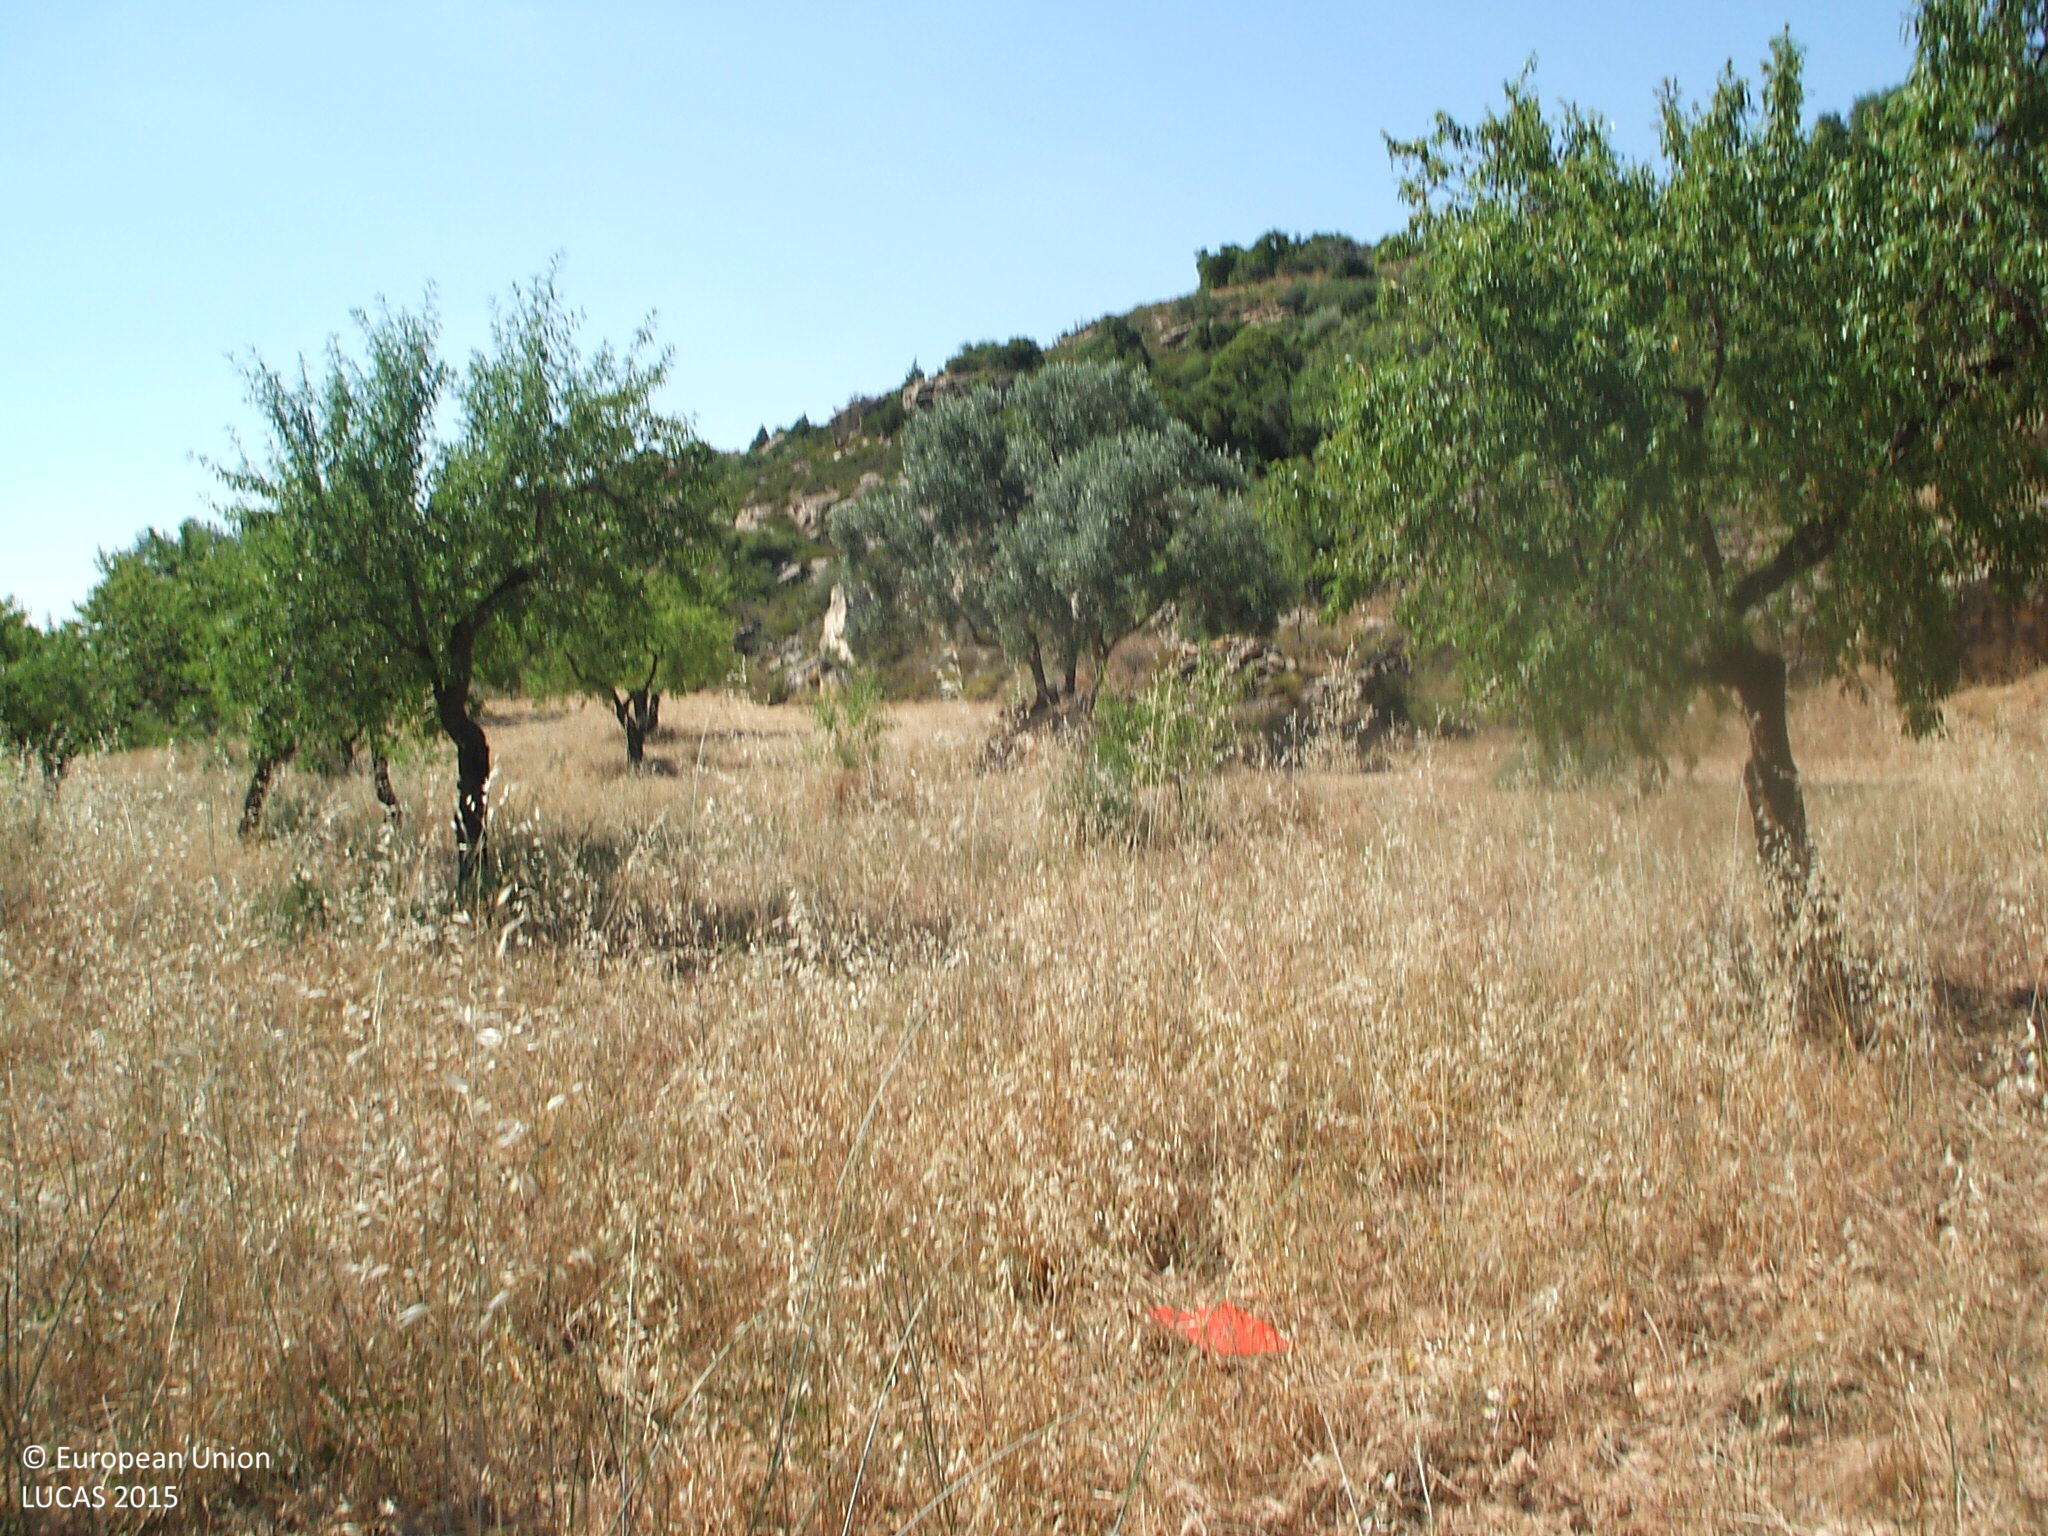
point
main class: Cropland
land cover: Nuts trees
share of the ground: 25 - 50 %
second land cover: Spontaneously vegetated surfaces
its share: > 75 %
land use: Agriculture (excluding fallow land and kitchen gardens)
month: June
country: ES
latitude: 40.9880
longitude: -0.0544
